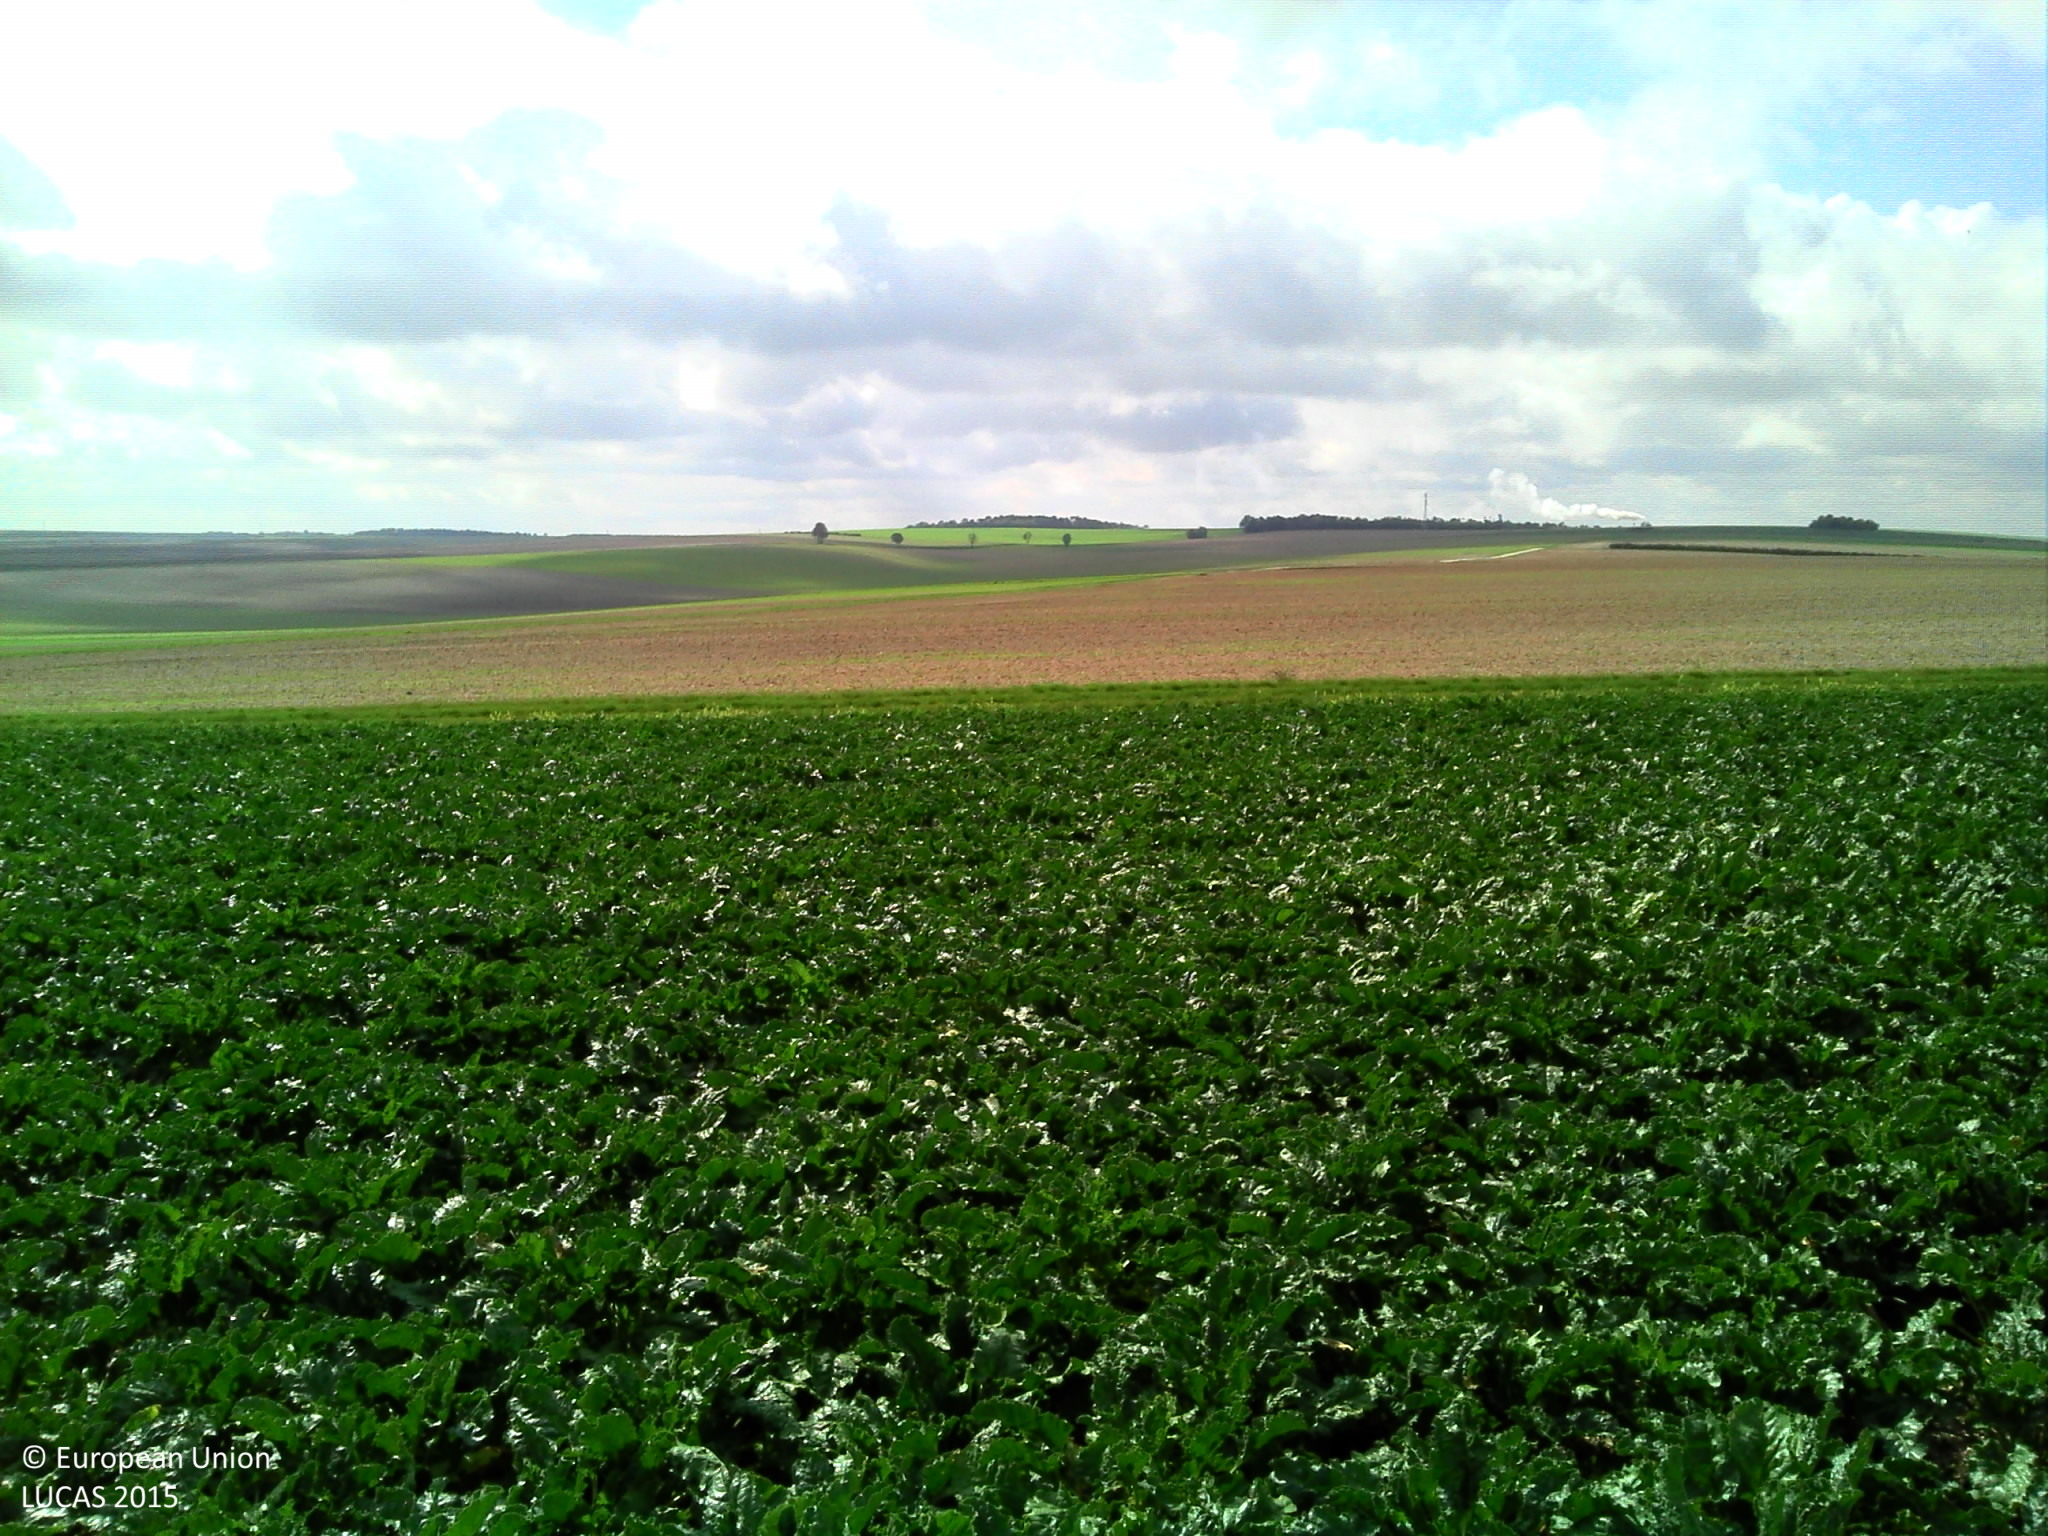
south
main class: Cropland
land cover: Sugar beet
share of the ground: > 75 %
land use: Agriculture (excluding fallow land and kitchen gardens)
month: September
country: FR
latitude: 48.3792
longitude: 4.2315
